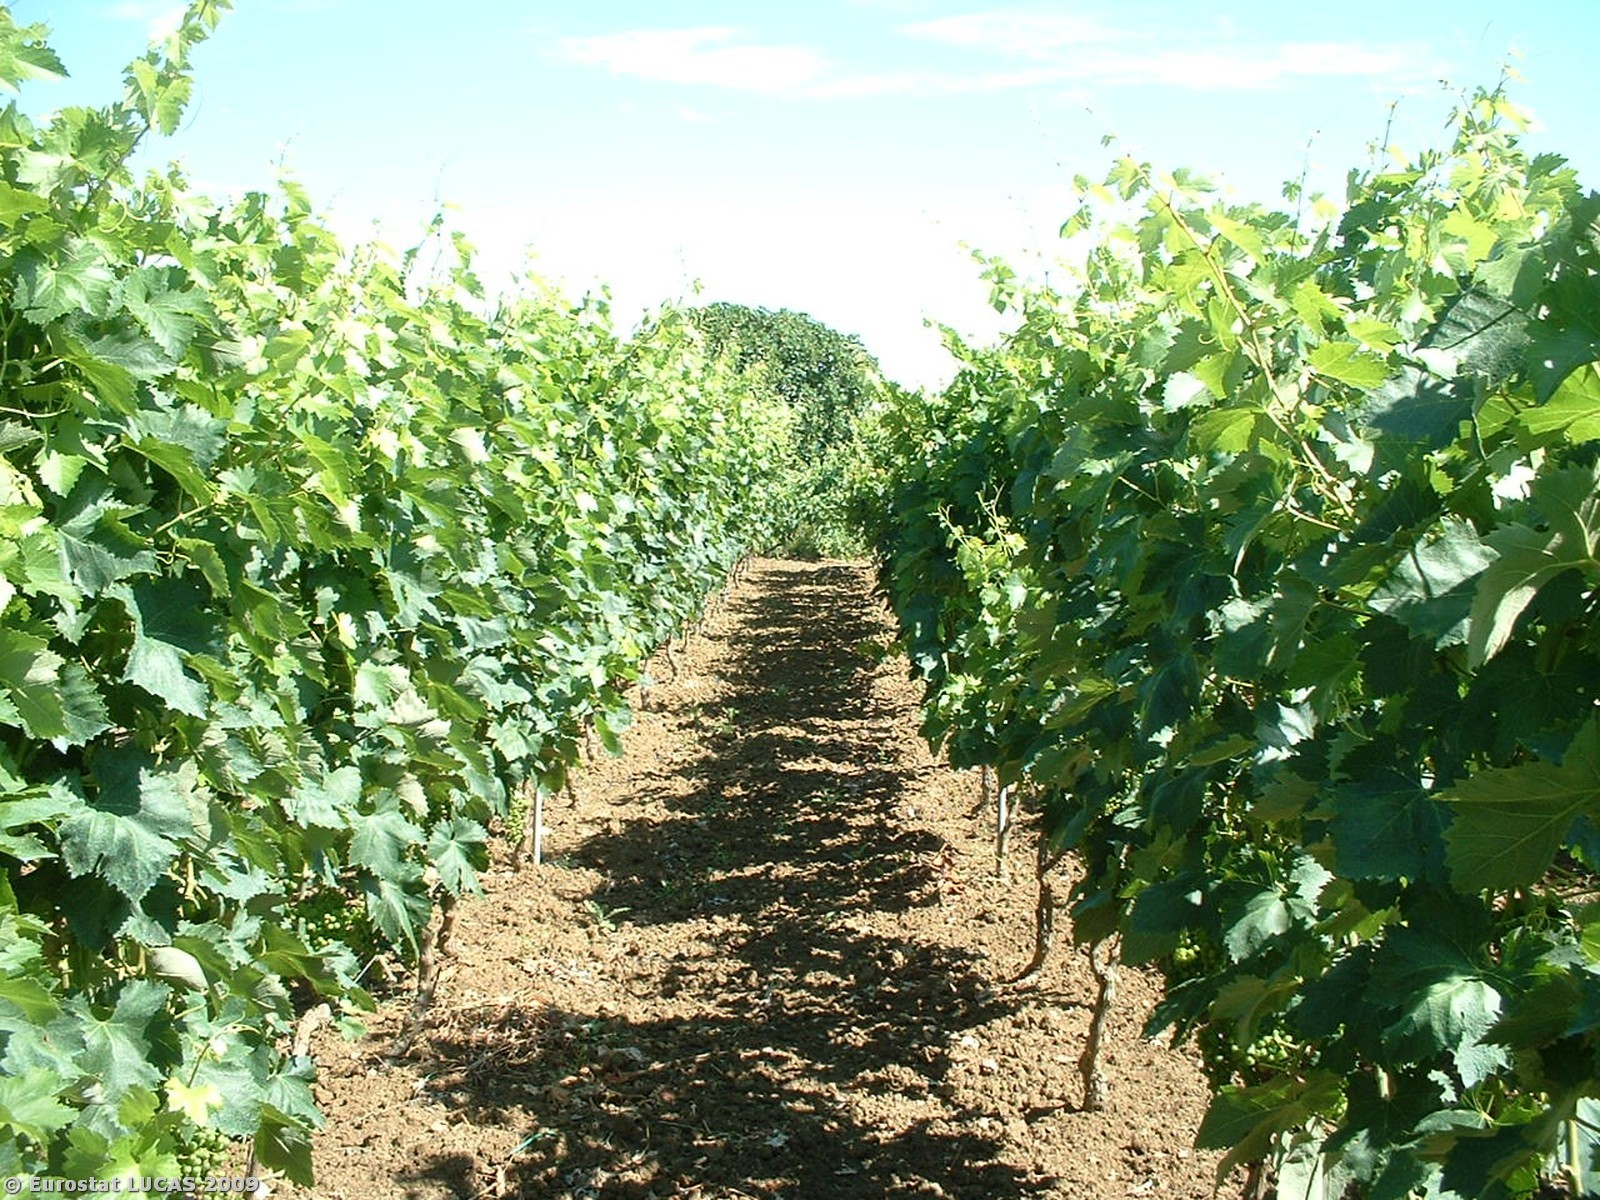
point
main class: Cropland
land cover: Vineyards
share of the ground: 25 - 50 %
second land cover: Bare land
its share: > 75 %
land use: Agriculture (excluding fallow land and kitchen gardens)
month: May
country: IT
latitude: 40.1493
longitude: 18.1089
